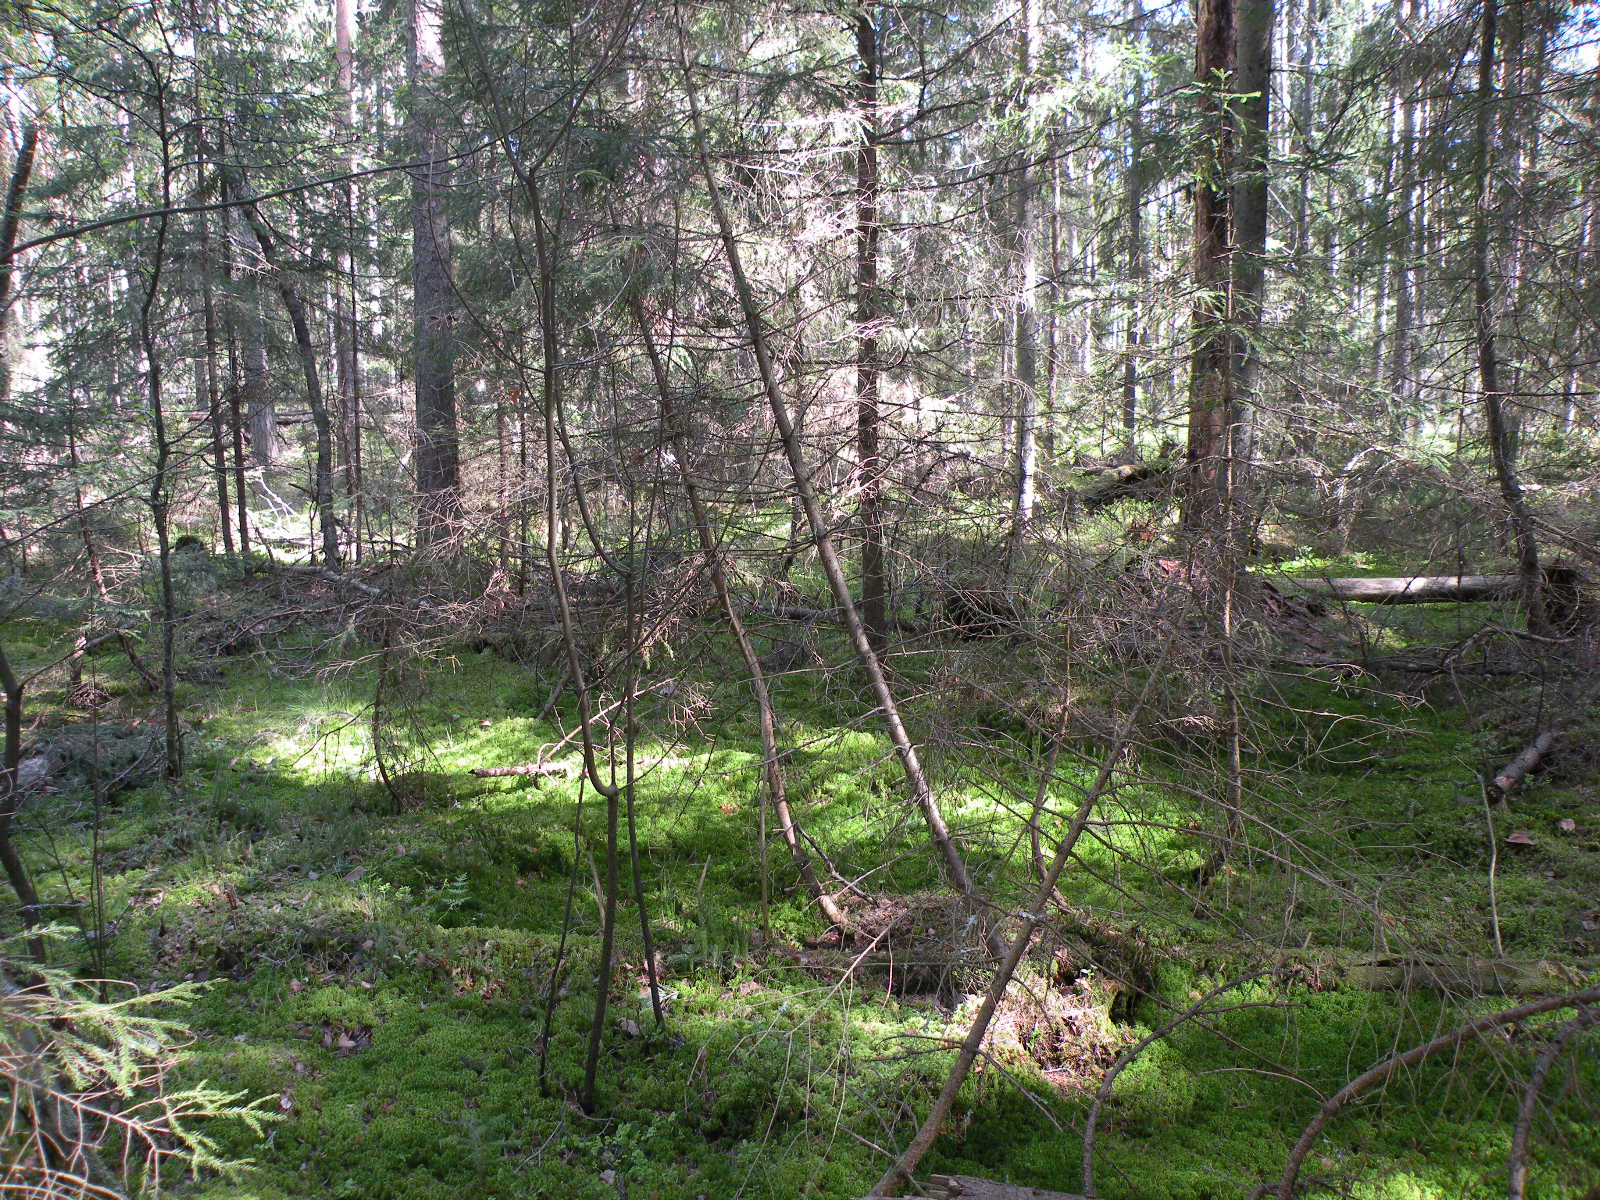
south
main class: Woodland
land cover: Spruce dominated coniferous woodland
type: hemiboreal forest and nemoral coniferous forest and mixed broadleaved-coniferous forest
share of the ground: > 75 %
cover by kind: coniferous forest trees 100 %
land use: Forestry
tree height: > 5 m
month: May
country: LV
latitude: 56.0956
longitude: 26.2656
